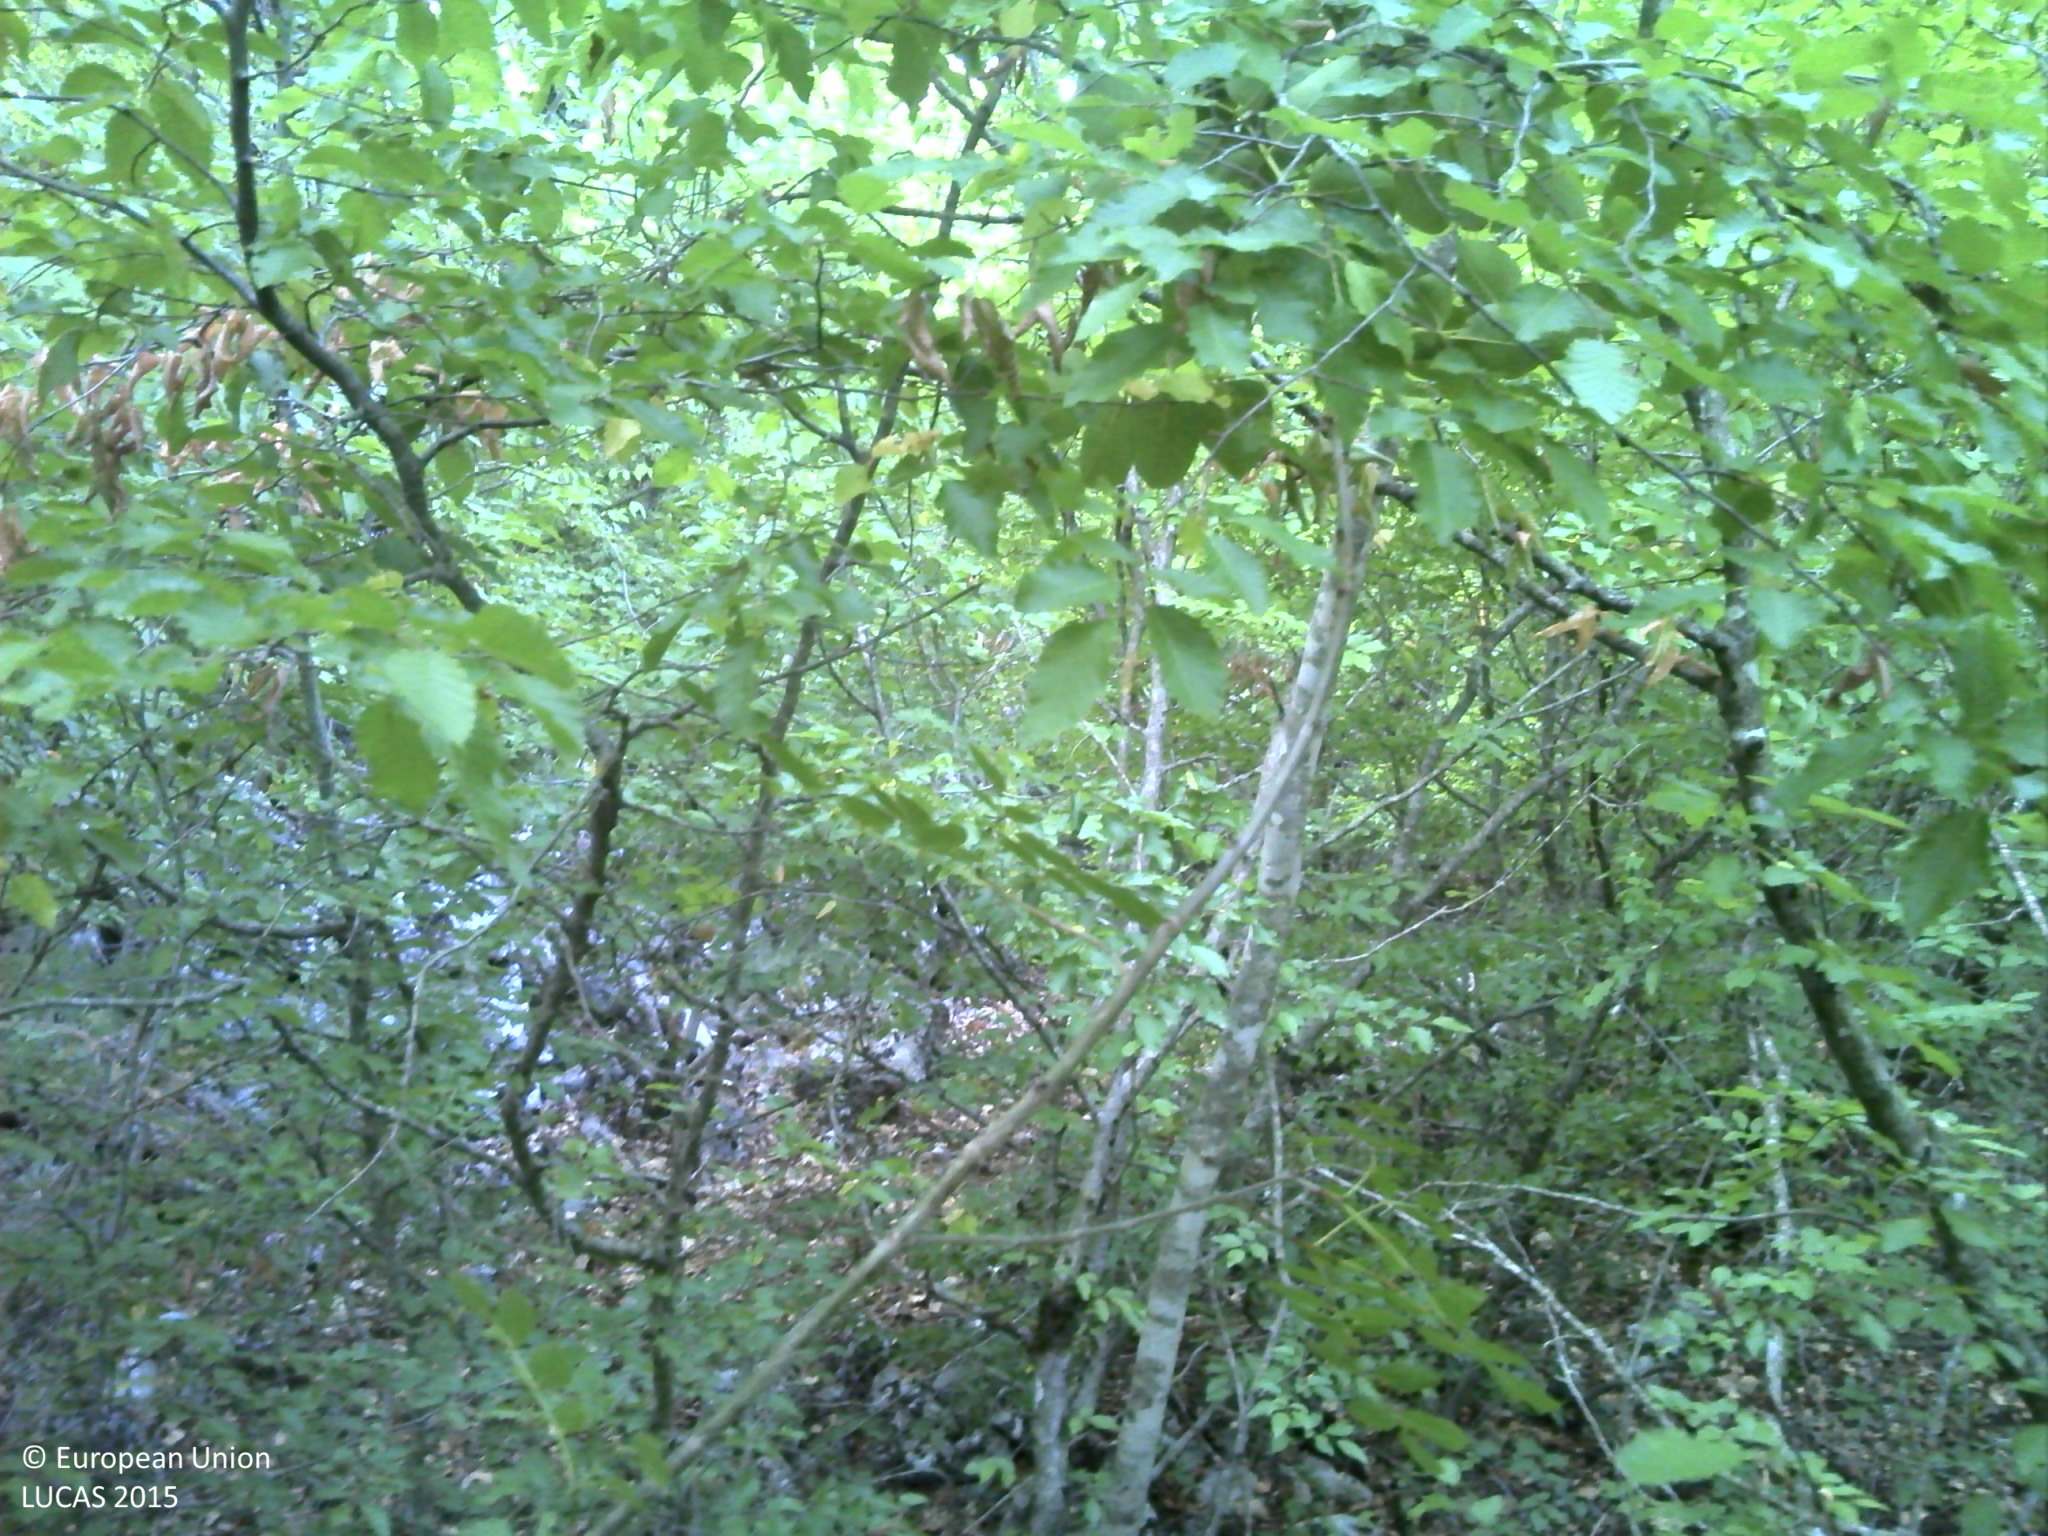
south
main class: Woodland
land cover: Other mixed woodland
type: thermophilous deciduous forest
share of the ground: > 75 %
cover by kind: broadleaved forest trees 55 %, coniferous forest trees 30 %, shrubs 10 %, consolidated bare surface 5 %
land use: Semi-natural and natural areas not in use
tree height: > 5 m
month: July
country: HR
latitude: 43.4511
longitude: 16.8991
